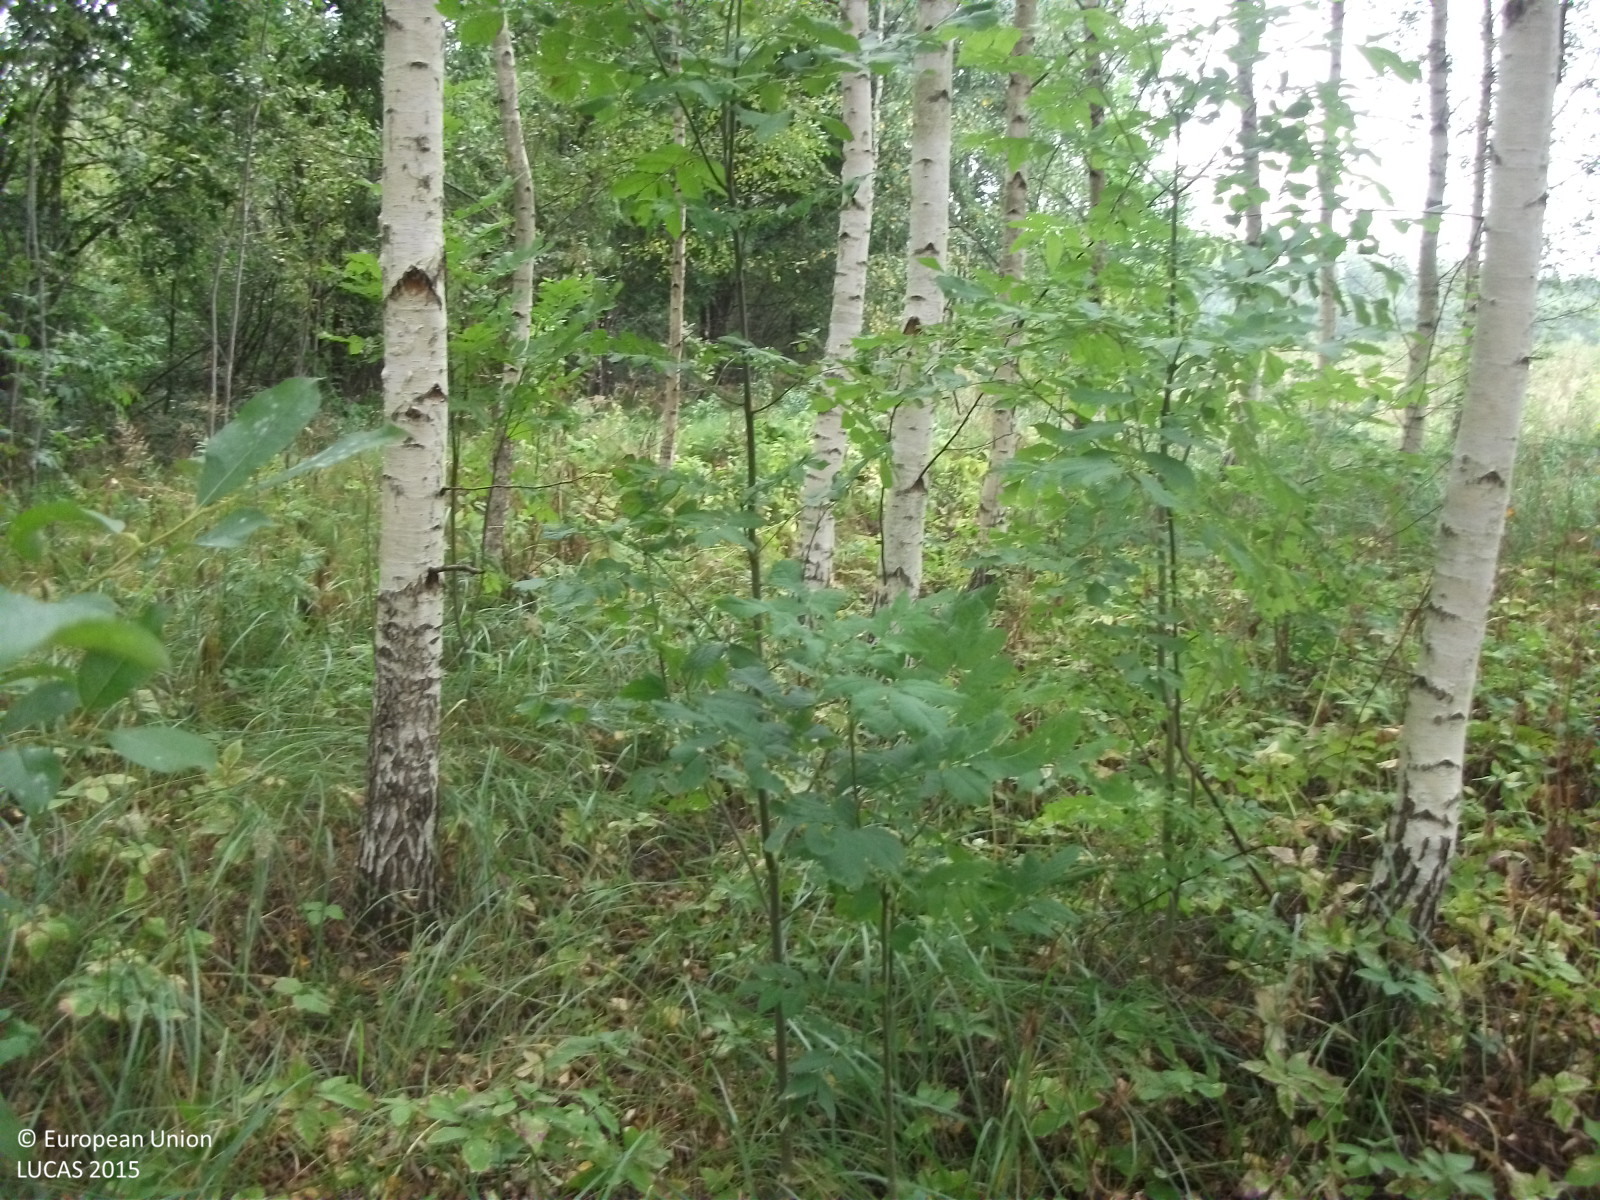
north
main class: Woodland
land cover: Broadleaved woodland
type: non-riverine alder, birch or aspen forest
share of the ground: 50 - 75 %
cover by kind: broadleaved forest trees 60 %, herbaceous plants 30 %, shrubs 10 %
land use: Forestry
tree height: > 5 m
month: September
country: LV
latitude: 57.4757
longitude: 24.7211
